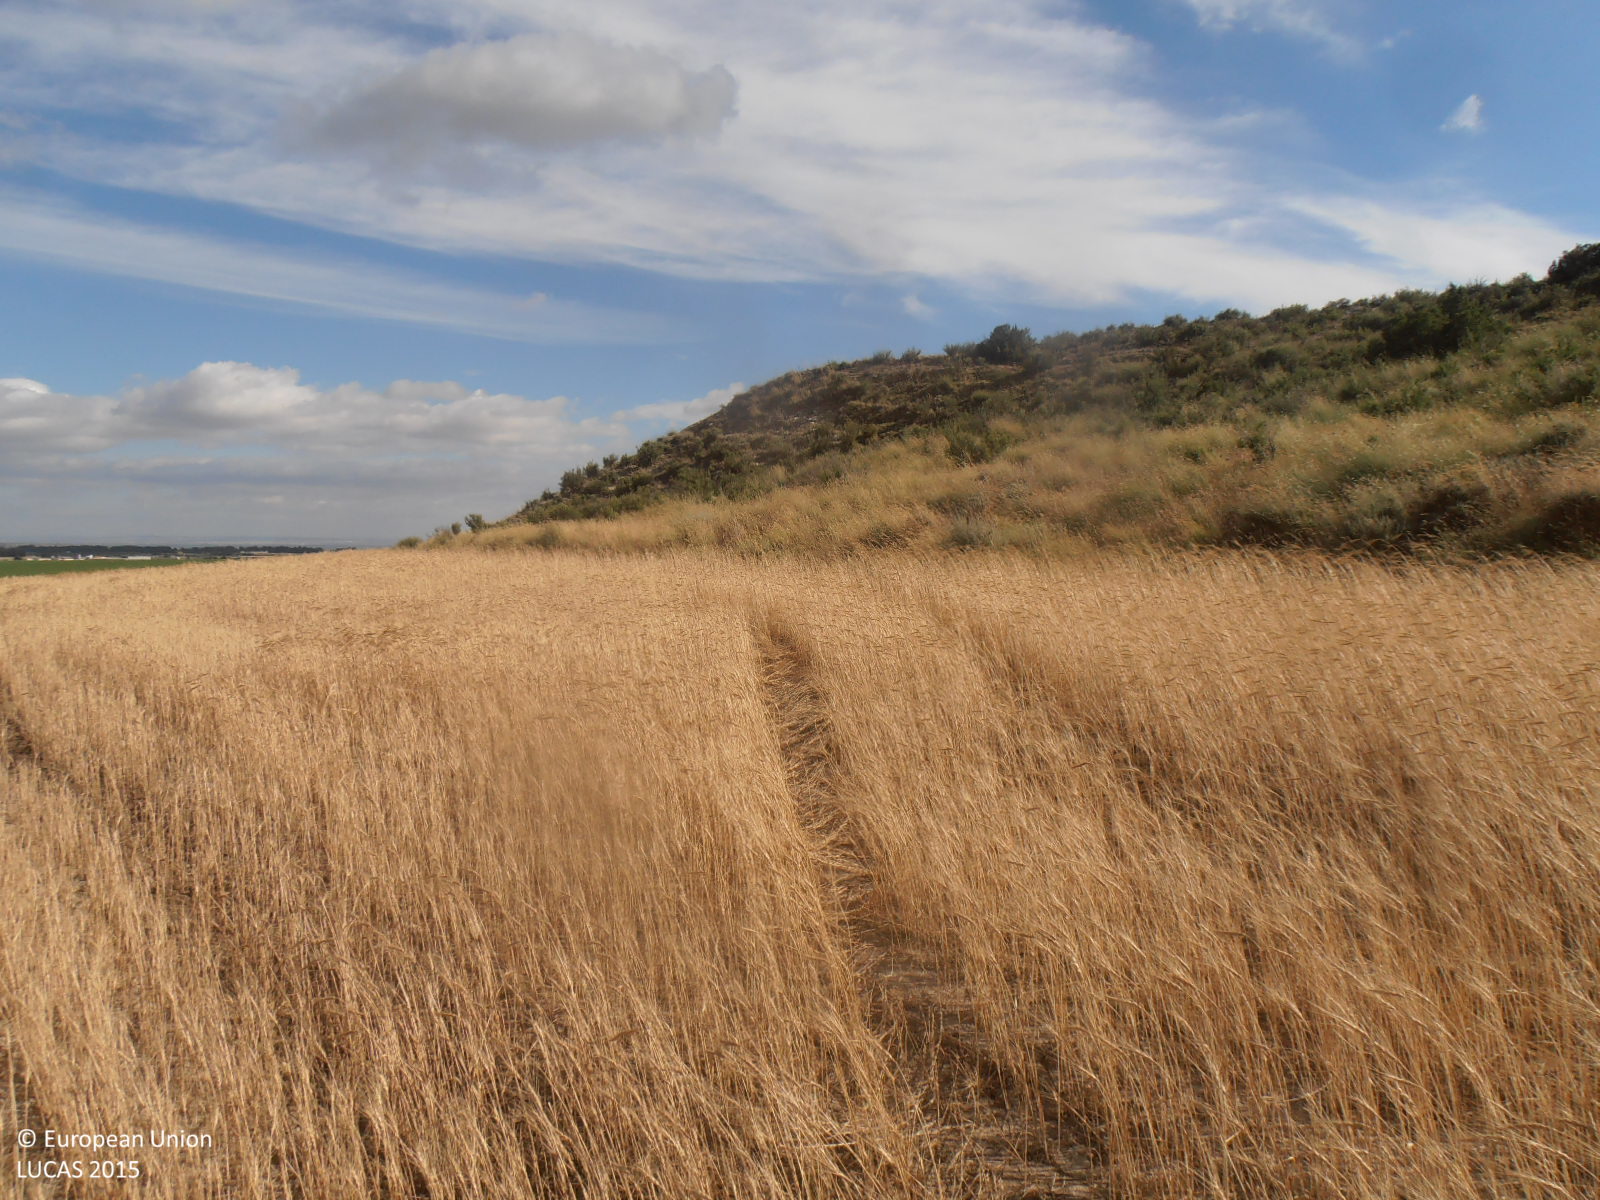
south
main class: Cropland
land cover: Common wheat
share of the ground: > 75 %
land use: Agriculture (excluding fallow land and kitchen gardens)
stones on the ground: < 10 %
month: June
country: ES
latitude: 41.9995
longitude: -1.3166
